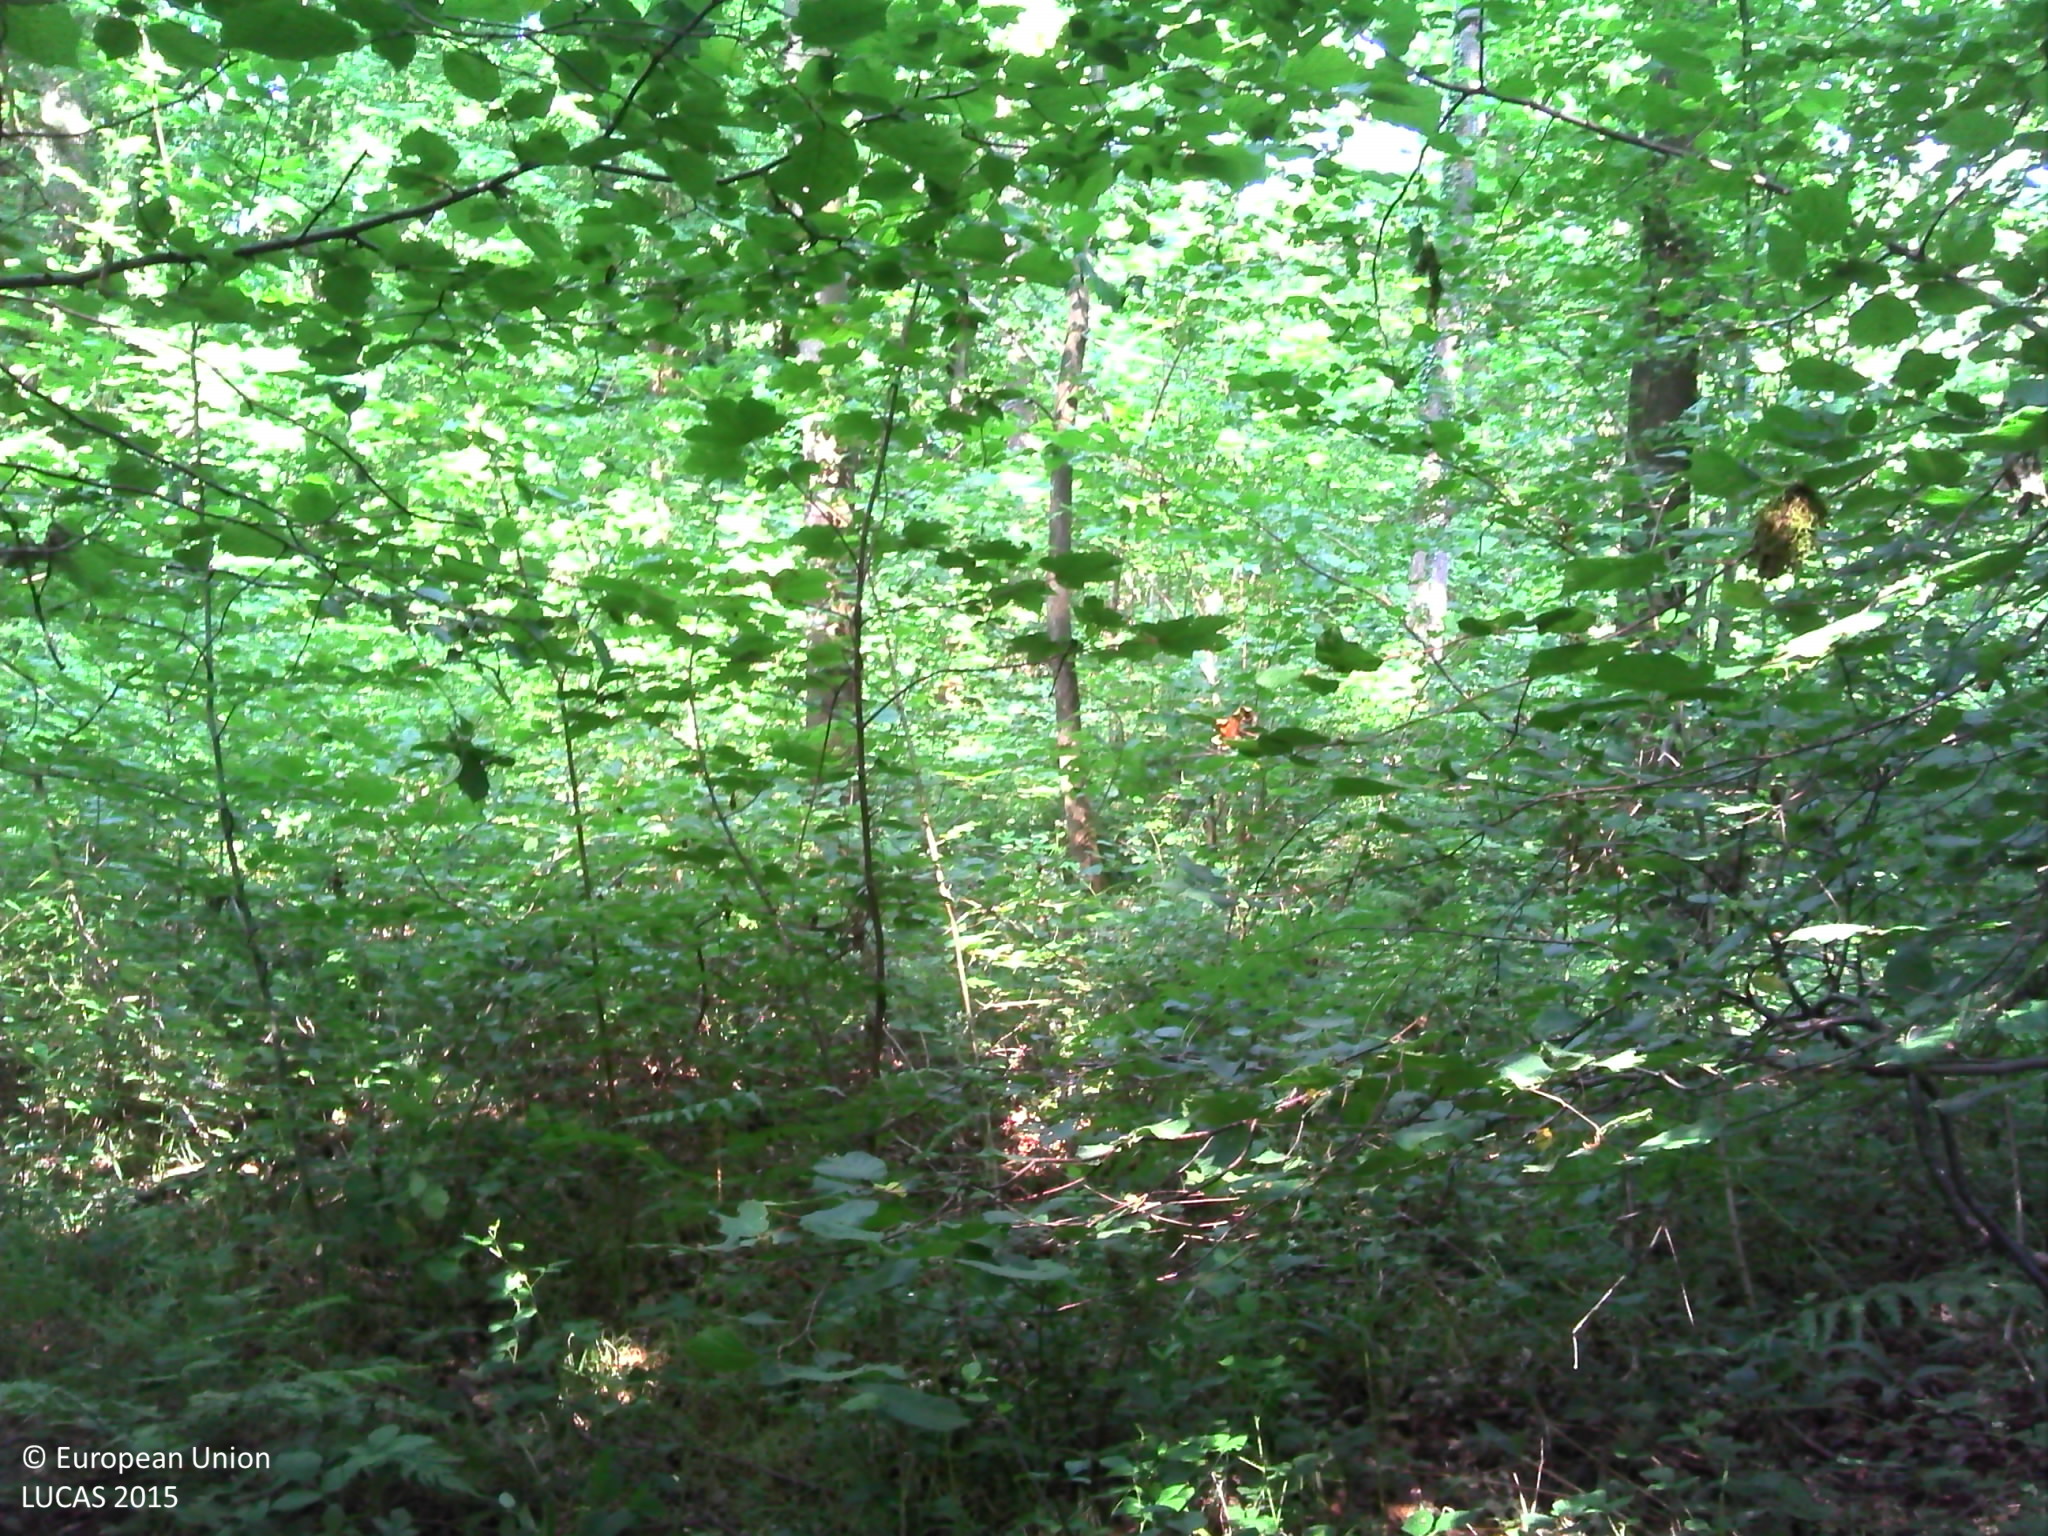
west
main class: Woodland
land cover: Broadleaved woodland
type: acidophilous oak and oak-birch forest
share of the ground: > 75 %
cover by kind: broadleaved forest trees 100 %
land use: Forestry
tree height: > 5 m
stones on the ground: < 10 %
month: July
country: BE
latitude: 50.2903
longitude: 4.5923
